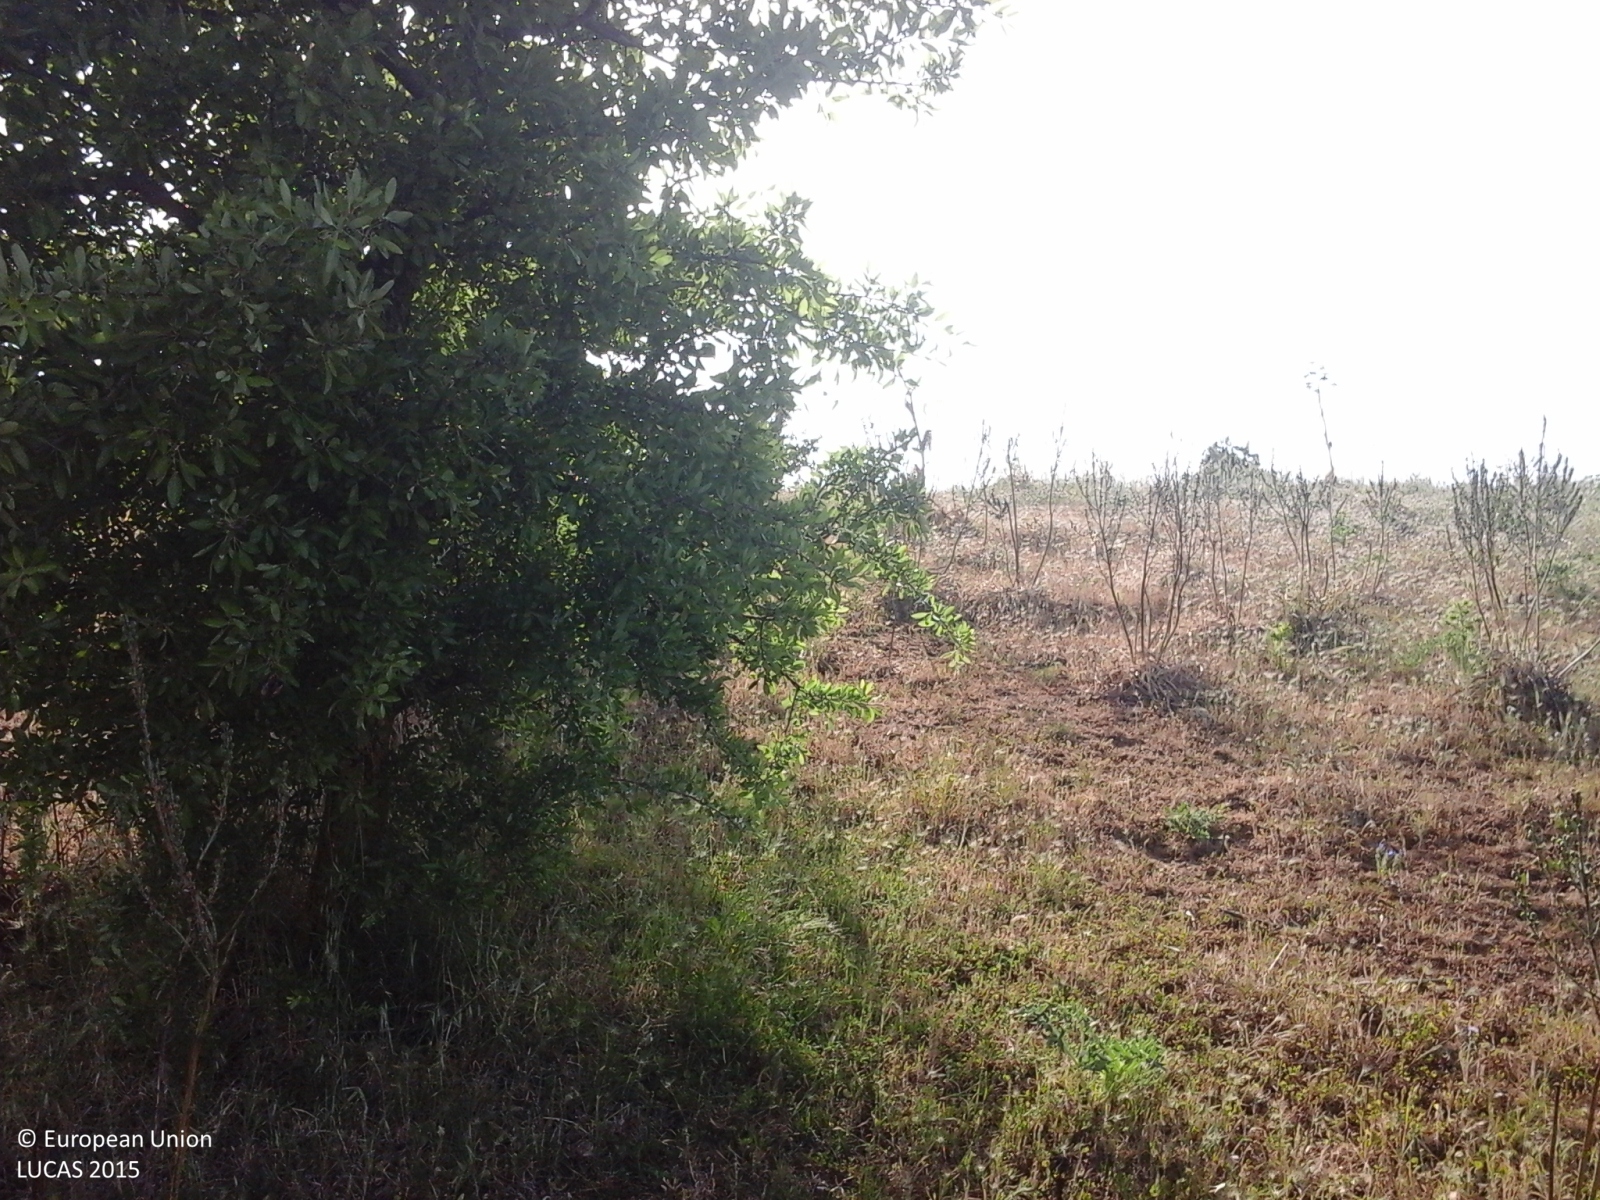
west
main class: Grassland
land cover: Grassland with sparse tree/shrub cover
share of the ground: > 75 %
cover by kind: herbaceous plants 90 %, broadleaved forest trees 5 %, shrubs 5 %
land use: Agriculture (excluding fallow land and kitchen gardens)
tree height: < 5 m
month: May
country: IT
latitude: 37.6979
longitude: 14.0422
